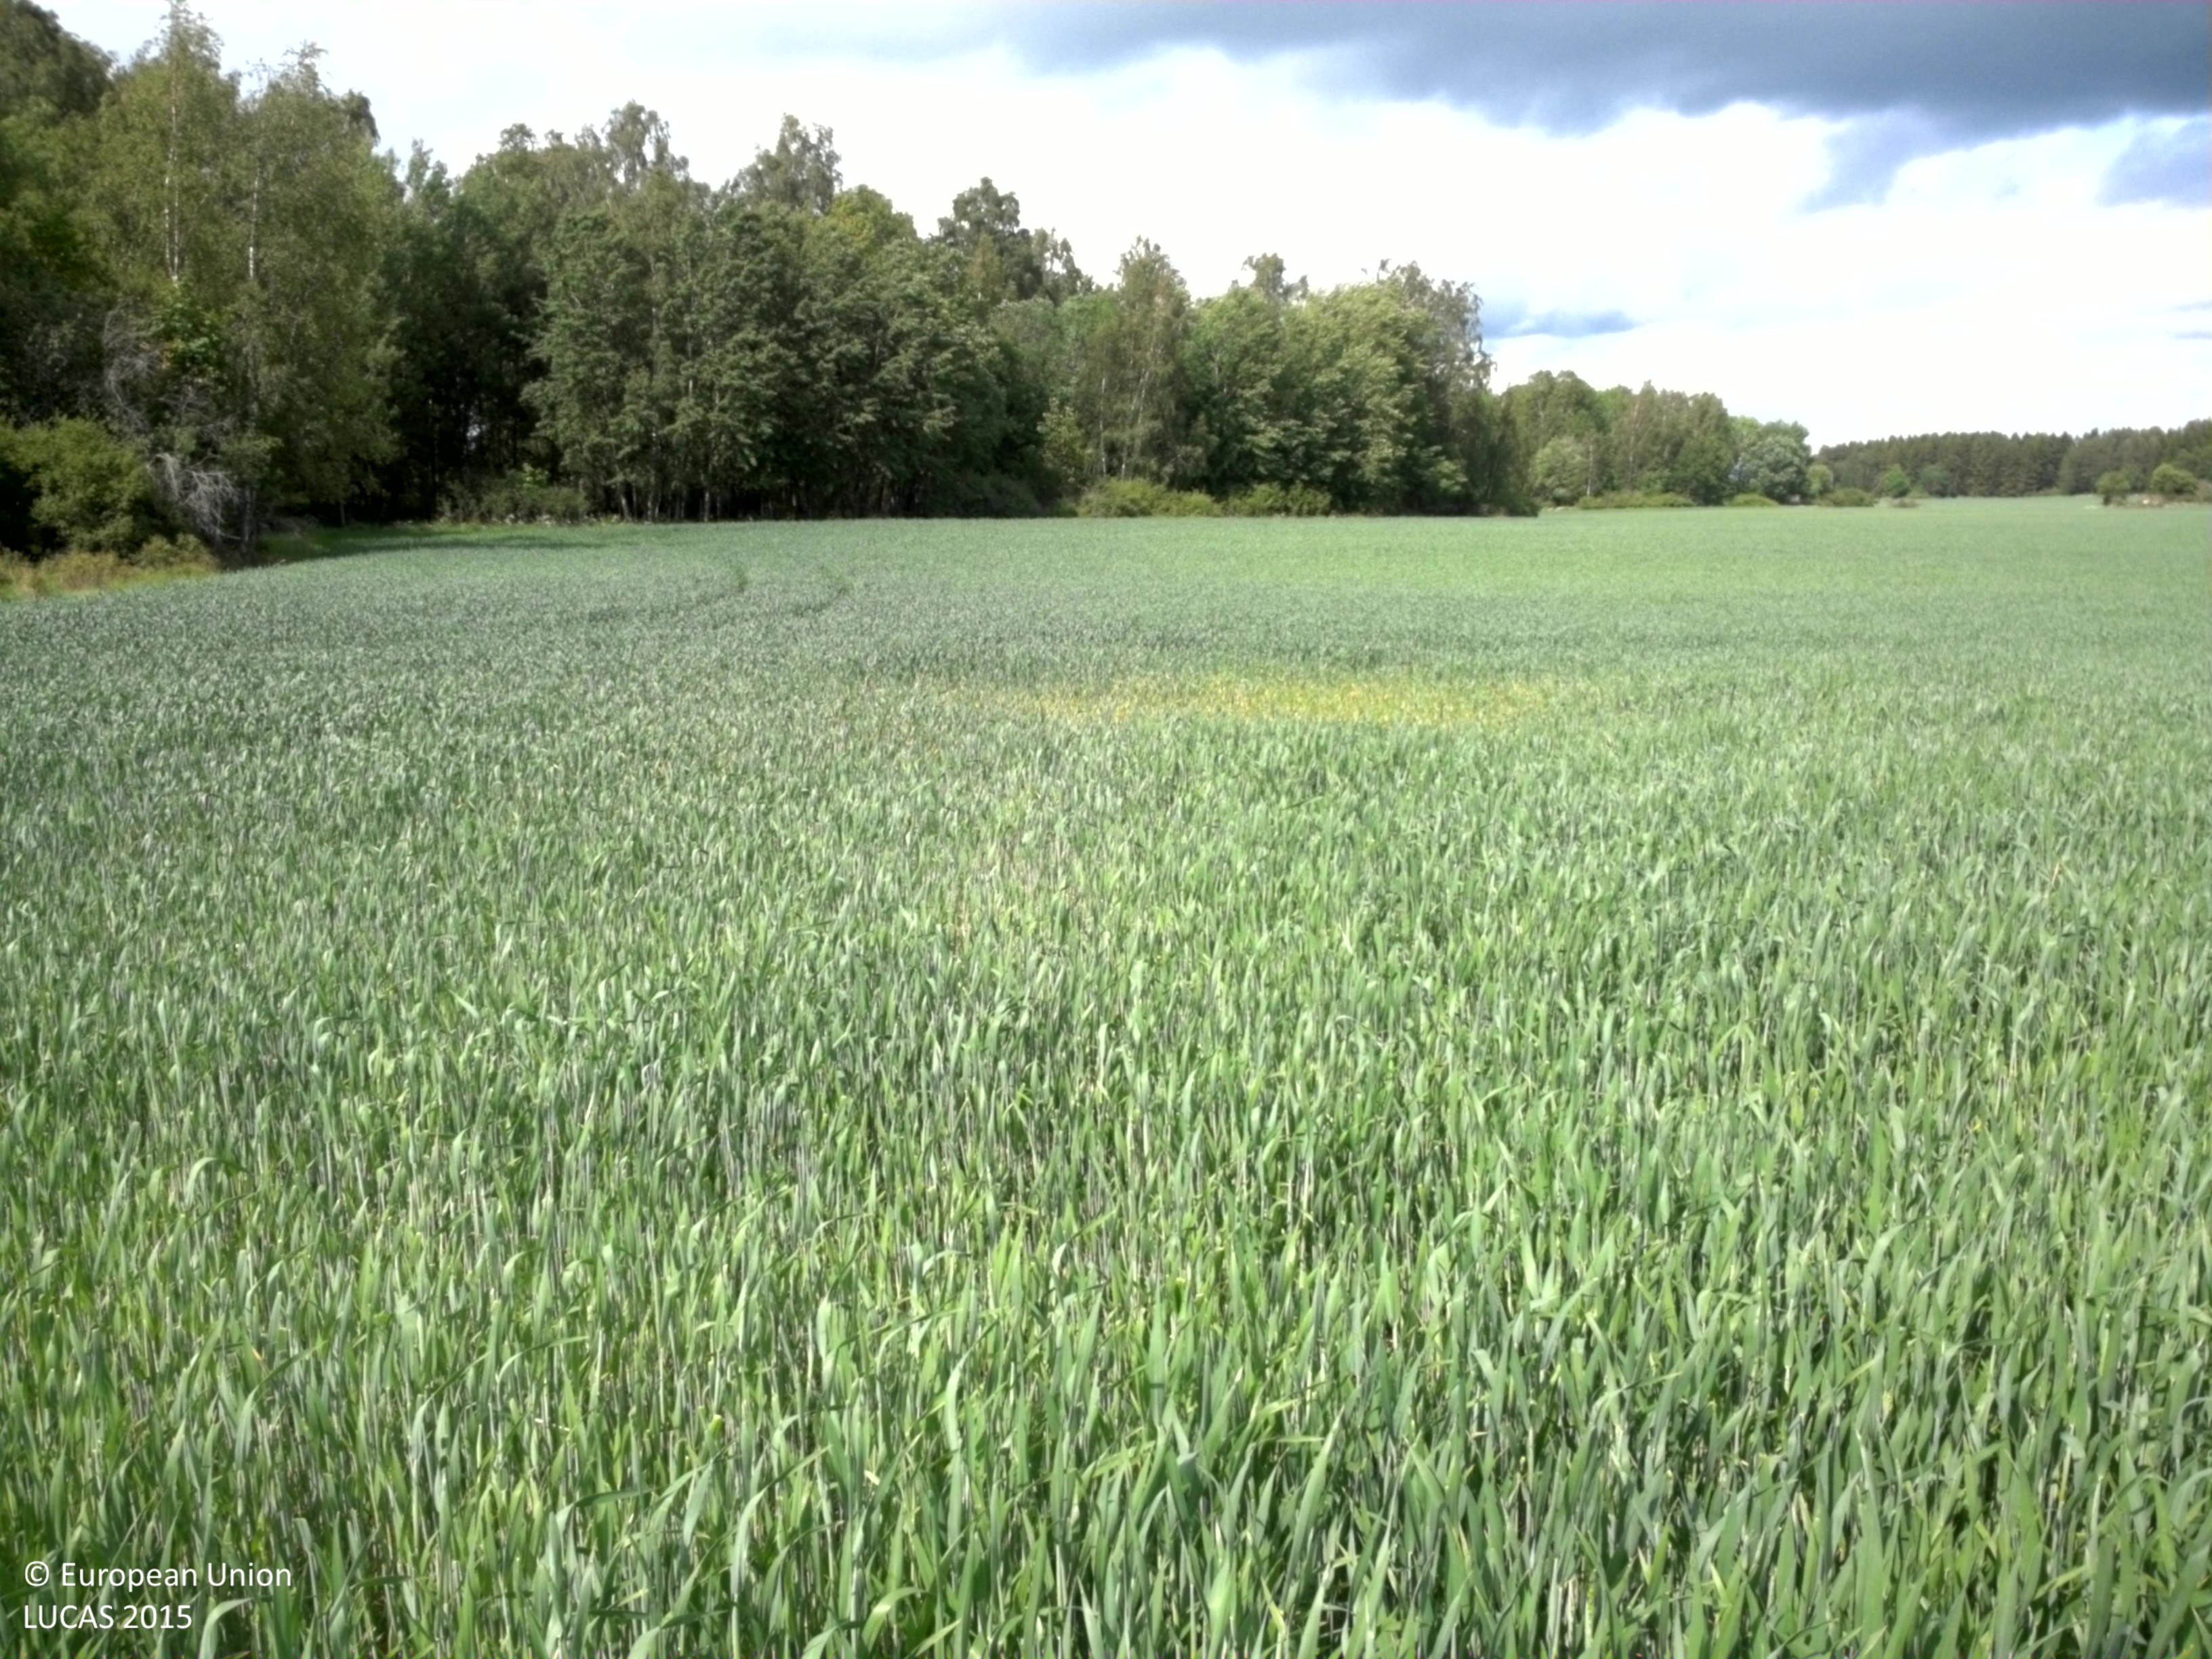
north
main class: Cropland
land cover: Common wheat
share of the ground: > 75 %
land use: Agriculture (excluding fallow land and kitchen gardens)
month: June
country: SE
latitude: 59.5737
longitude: 16.9861
